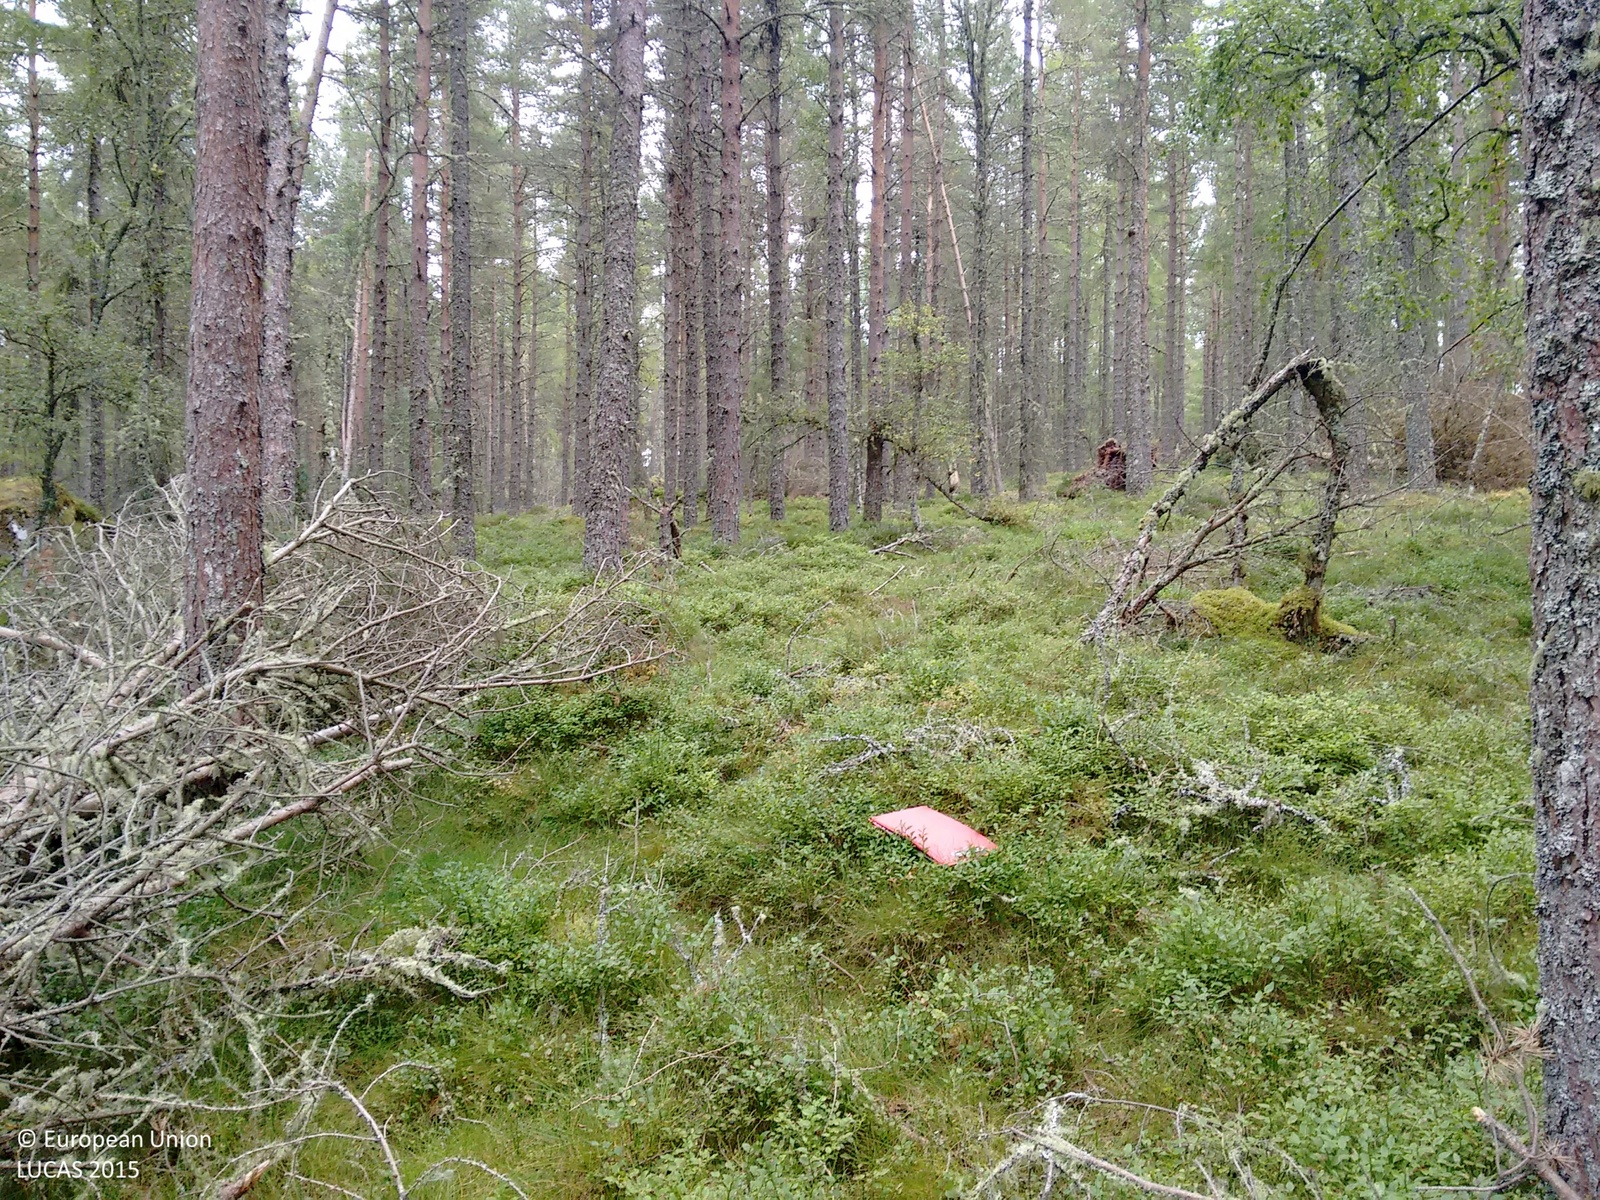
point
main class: Woodland
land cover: Pine dominated coniferous woodland
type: hemiboreal forest and nemoral coniferous forest and mixed broadleaved-coniferous forest
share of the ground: > 75 %
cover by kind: coniferous forest trees 80 %, shrubs 15 %, herbaceous plants 5 %
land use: Forestry
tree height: > 5 m
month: September
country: GB
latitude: 57.7407
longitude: -4.3135
